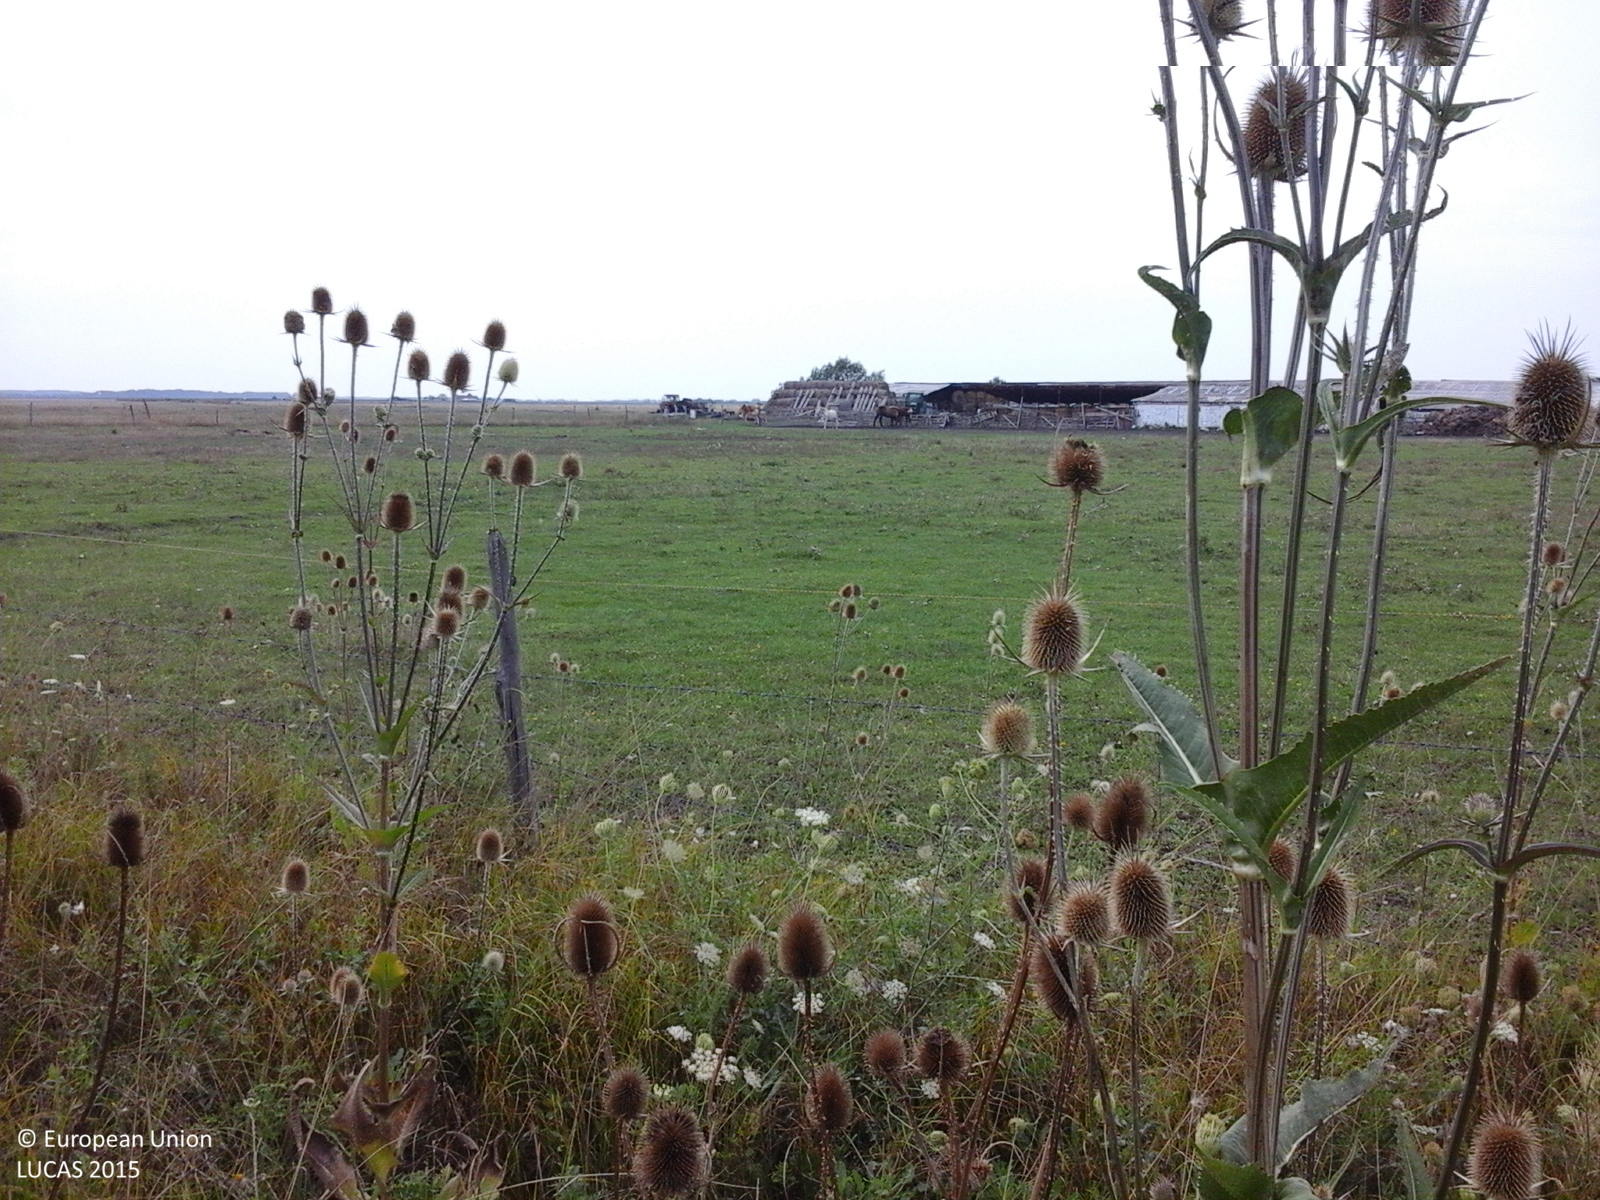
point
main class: Grassland
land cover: Grassland without tree/shrub cover
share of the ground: > 75 %
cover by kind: herbaceous plants 100 %
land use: Agriculture (excluding fallow land and kitchen gardens)
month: August
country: RO
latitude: 46.2748
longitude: 21.1536
